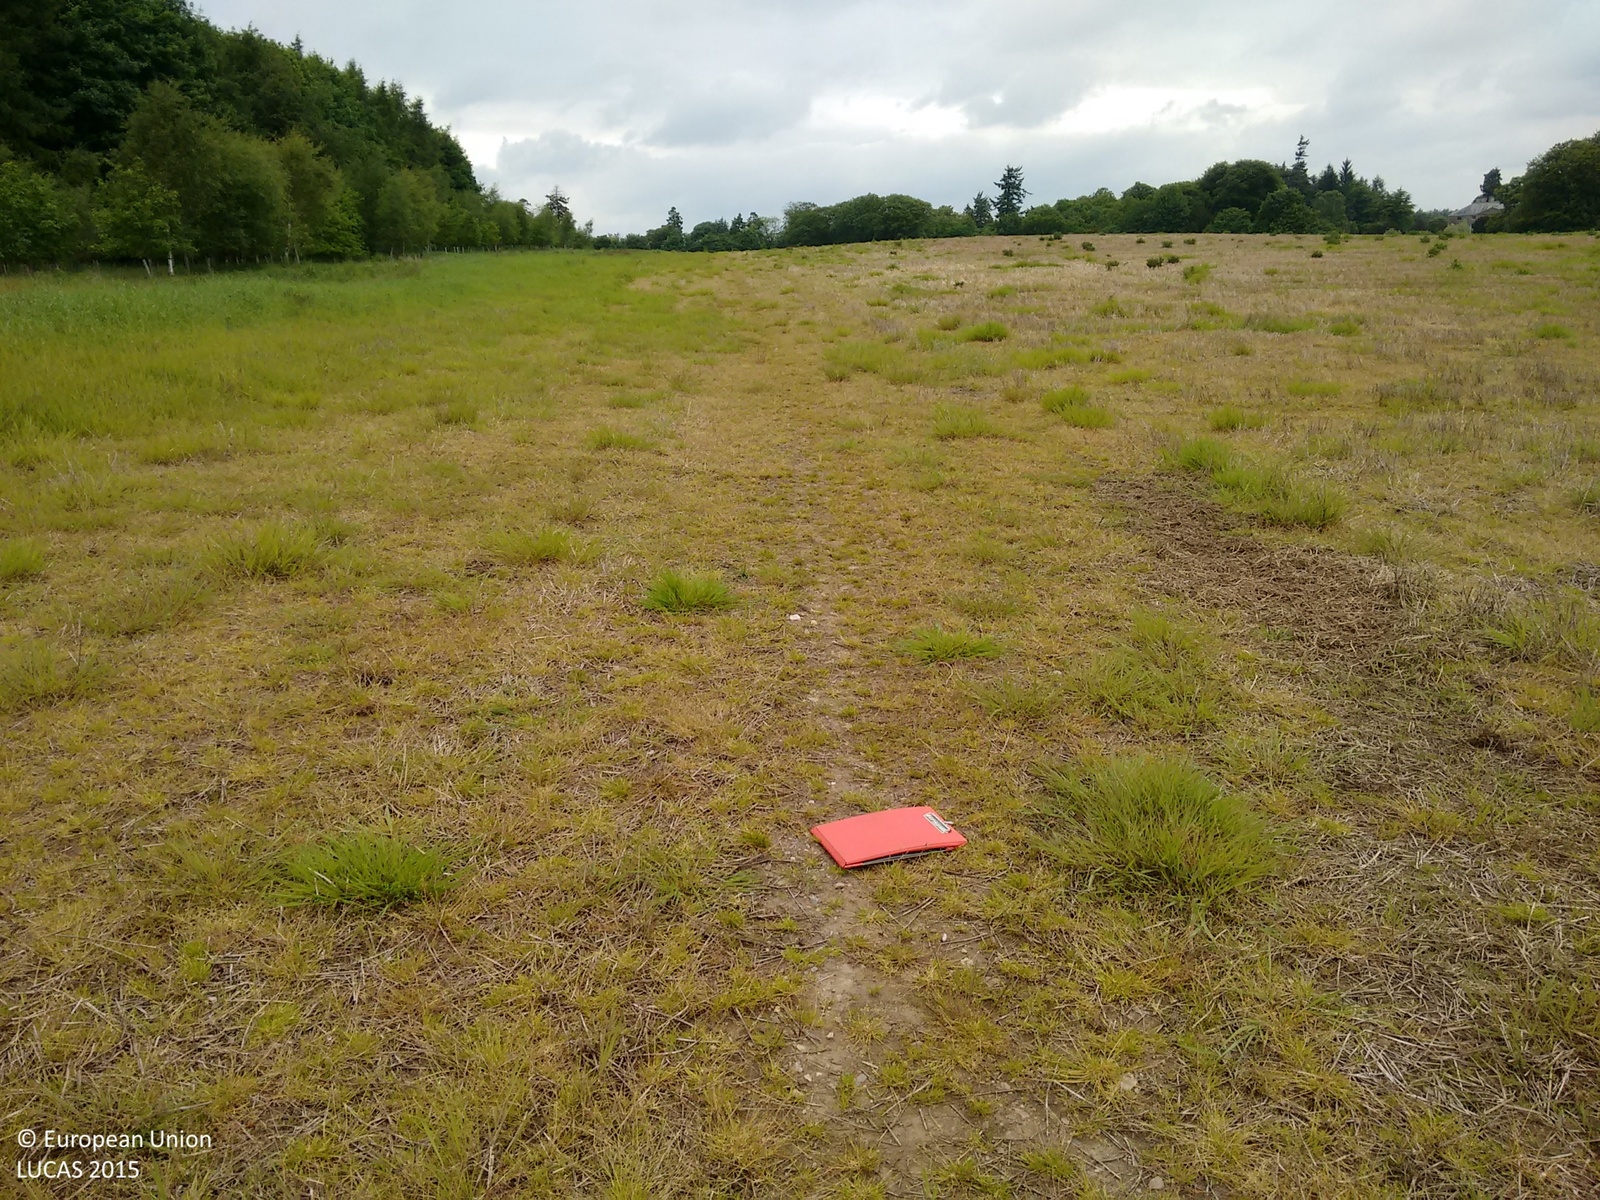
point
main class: Grassland
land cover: Spontaneously vegetated surfaces
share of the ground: > 75 %
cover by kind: herbaceous plants 85 %, unconsolidated bare surface 15 %
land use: Fallow land
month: June
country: GB
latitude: 56.4524
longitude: -3.3609
